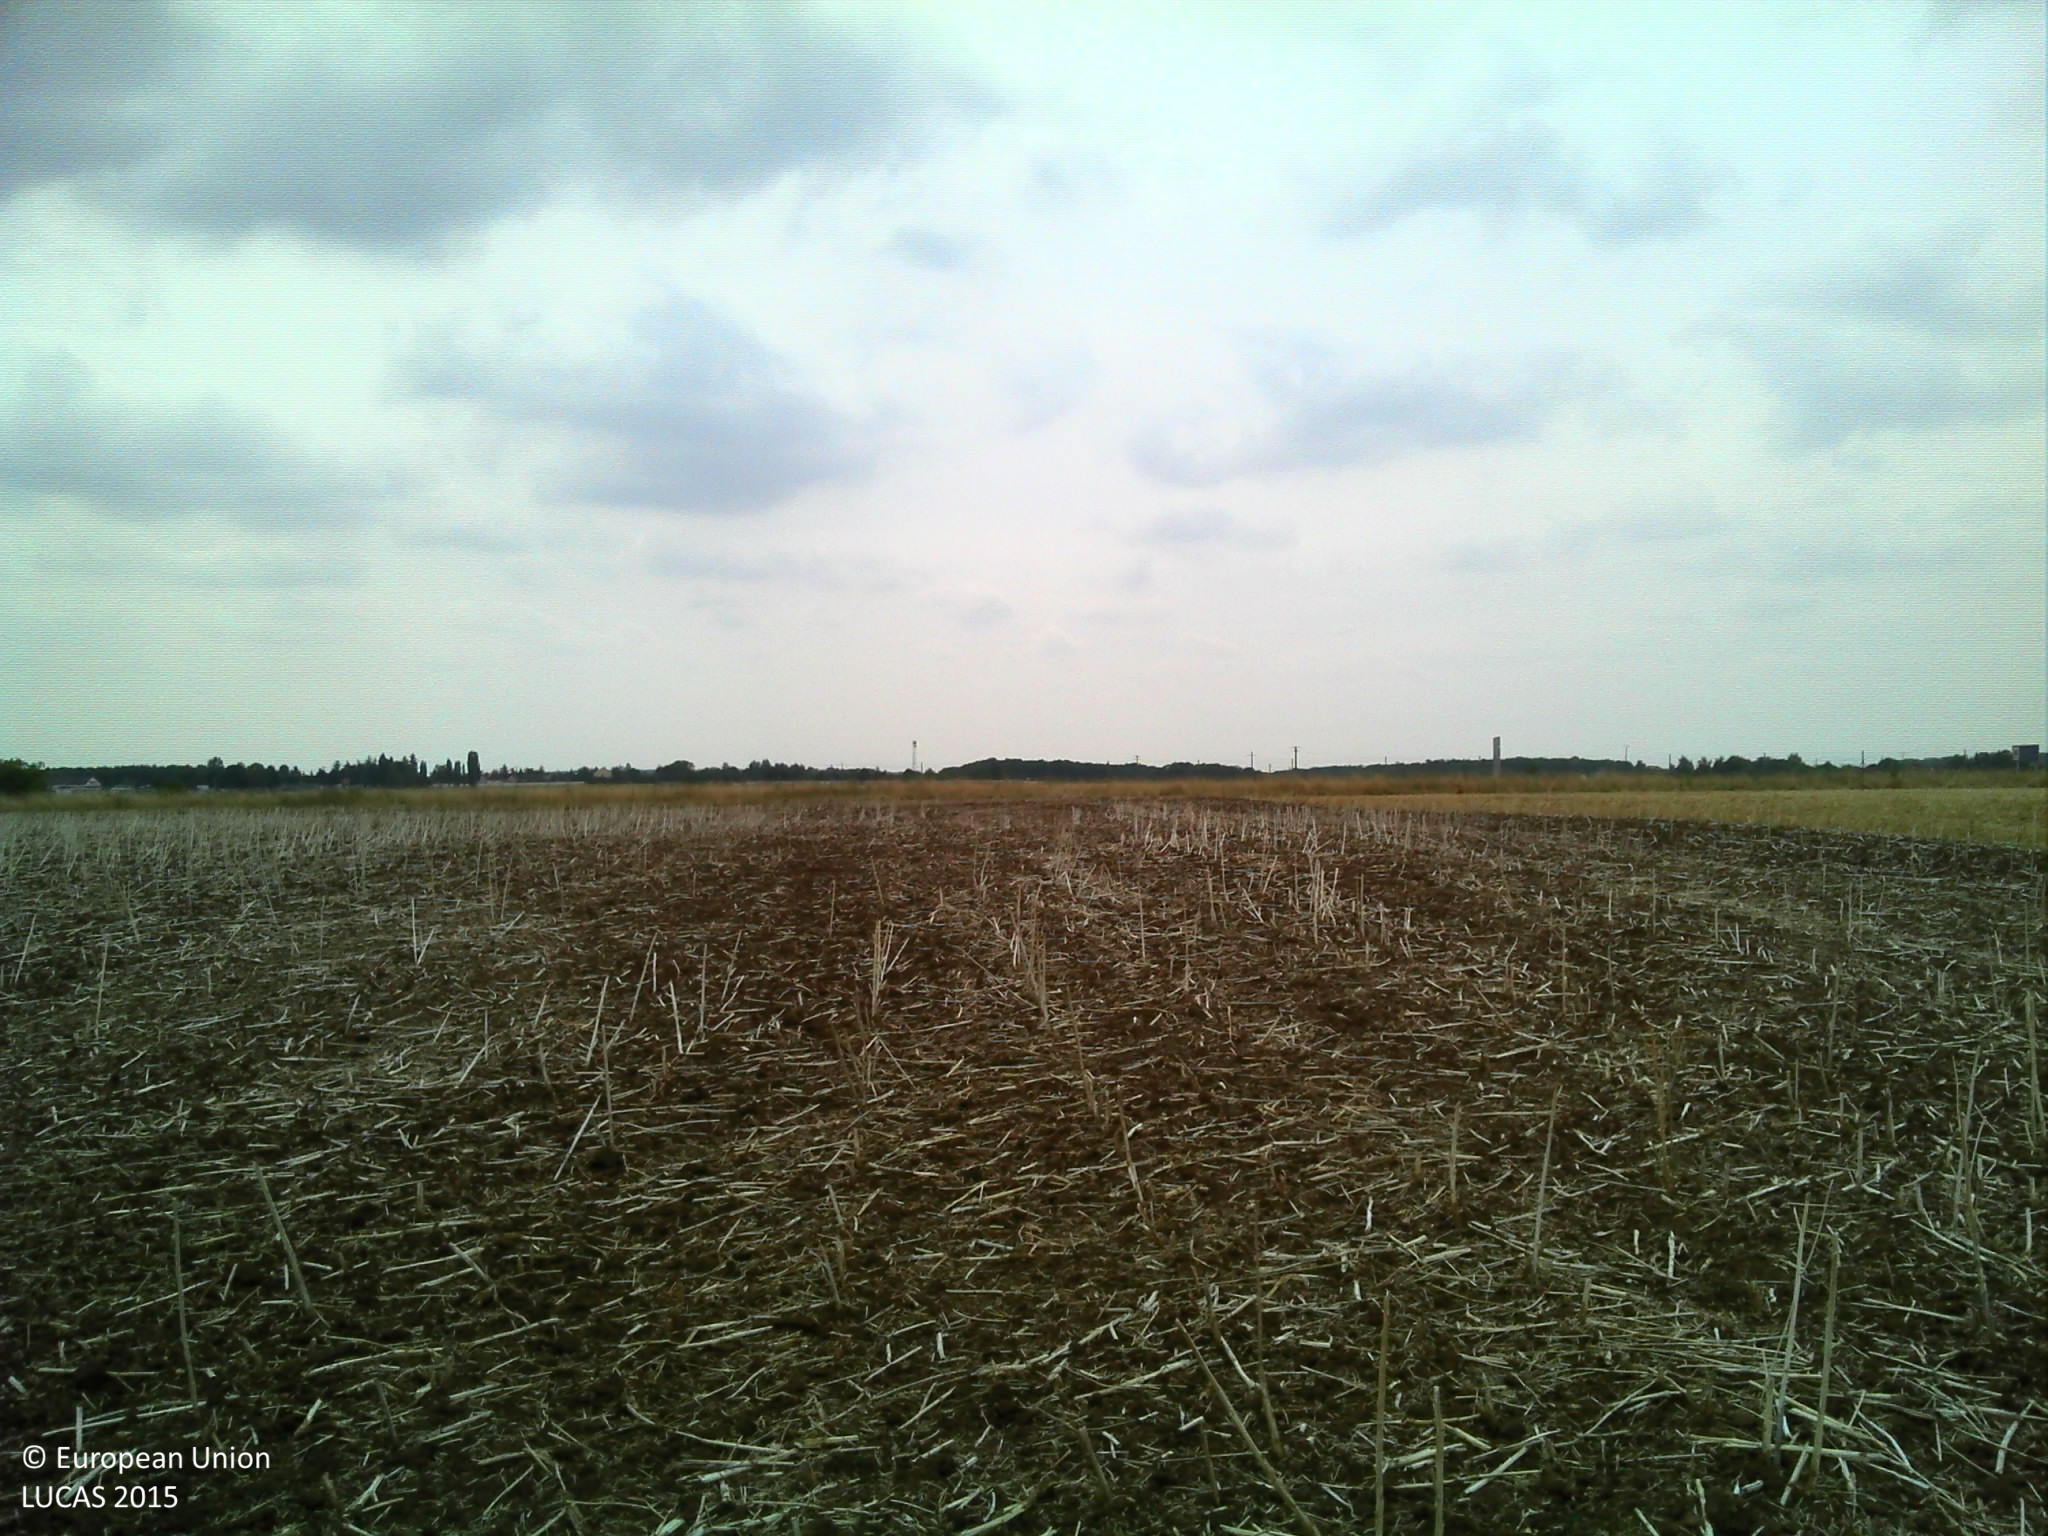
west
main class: Cropland
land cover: Rape and turnip rape
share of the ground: 10 - 25 %
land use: Agriculture (excluding fallow land and kitchen gardens)
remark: Harvested field
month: August
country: FR
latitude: 48.1846
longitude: 2.7685
